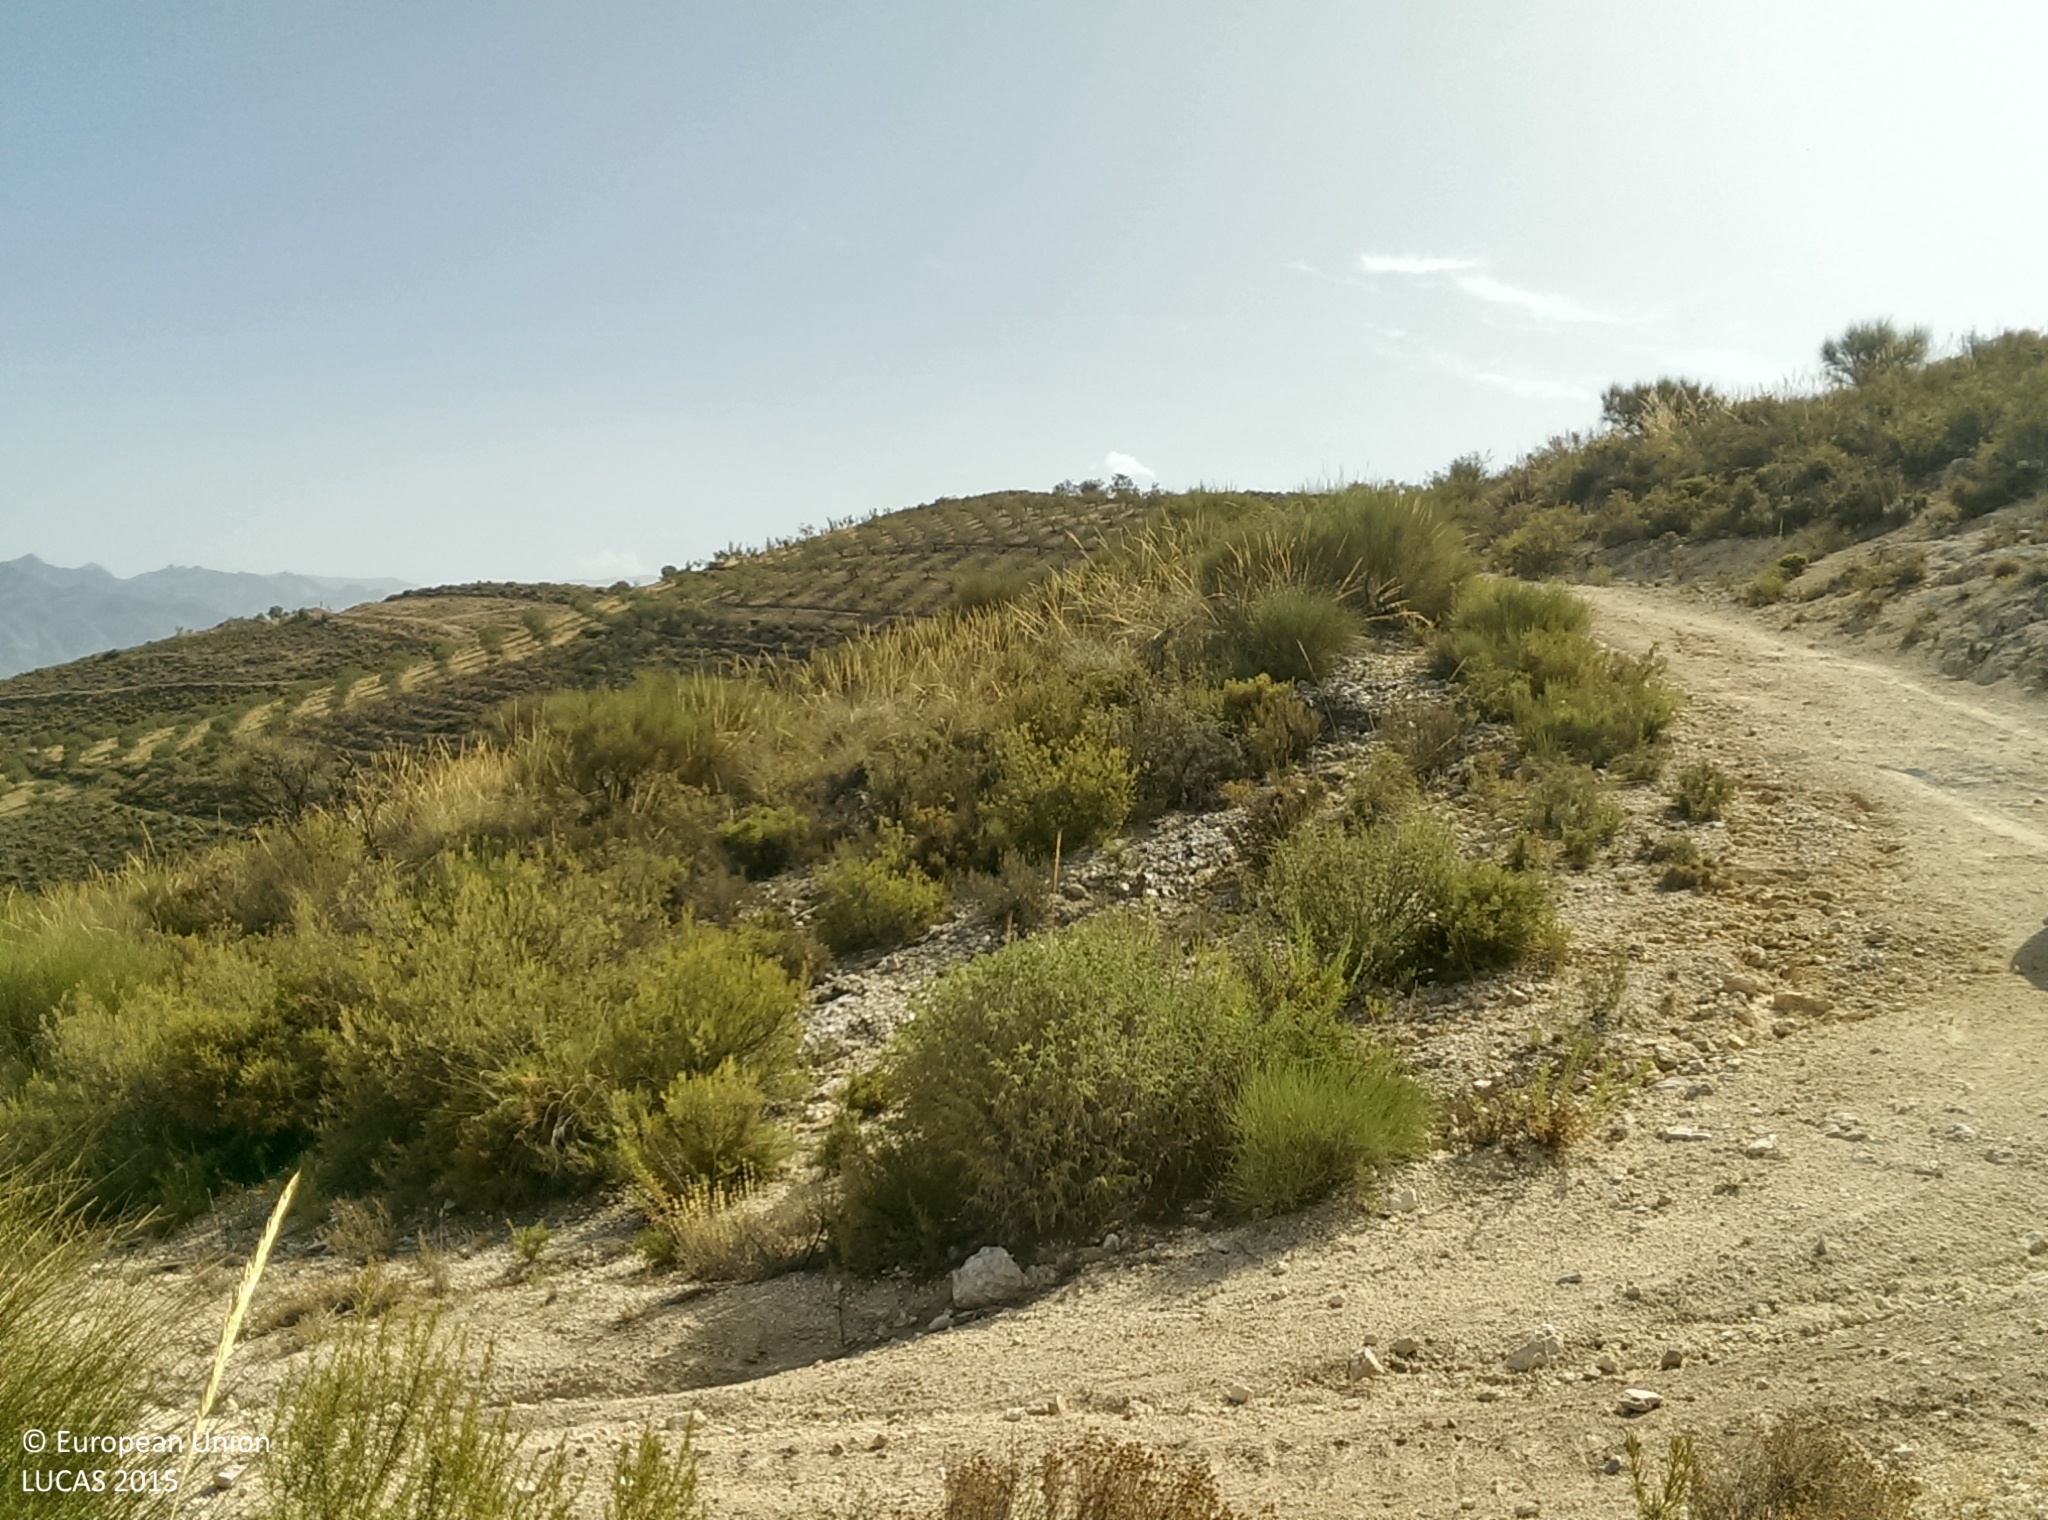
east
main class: Shrubland
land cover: Shrubland without tree cover
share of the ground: 50 - 75 %
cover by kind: shrubs 60 %, herbaceous plants 30 %, unconsolidated bare surface 10 %
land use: Abandoned areas
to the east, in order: Shrubland without tree cover; Rivers and streams; Shrubland without tree cover
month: August
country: ES
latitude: 36.9775
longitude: -3.6579
